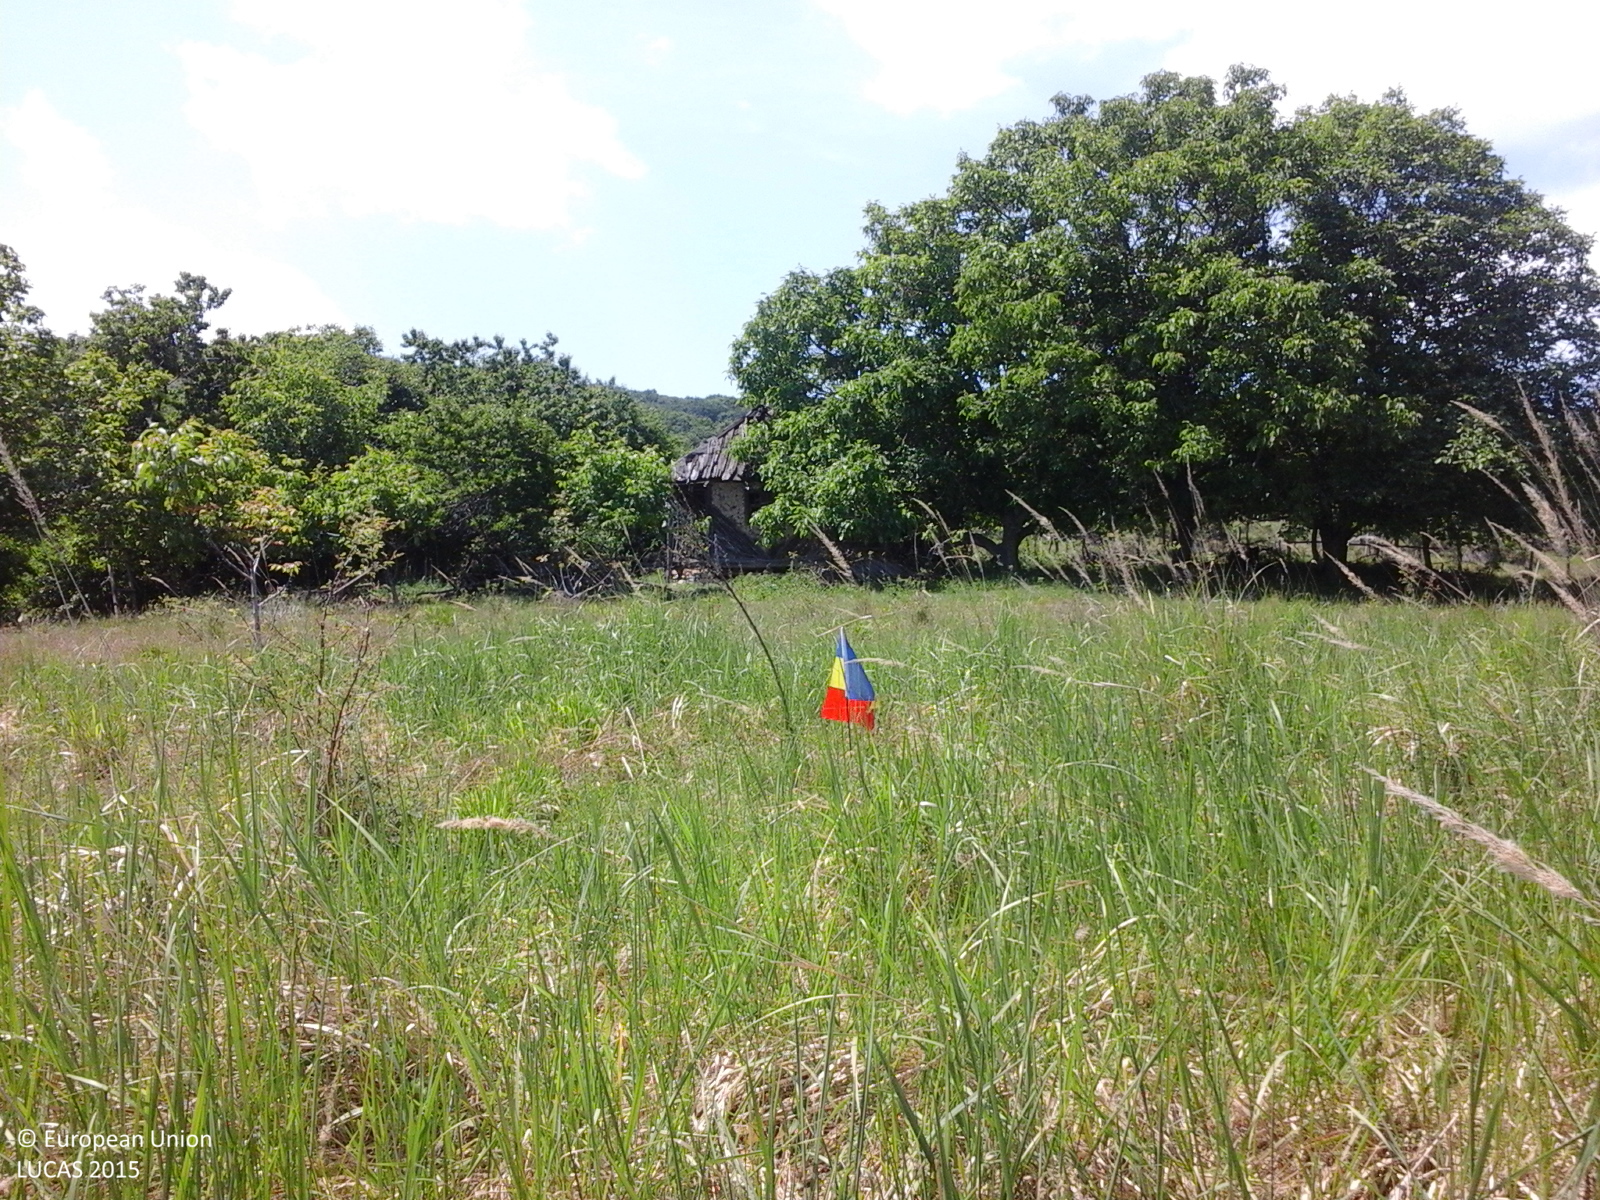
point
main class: Grassland
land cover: Grassland without tree/shrub cover
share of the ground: > 75 %
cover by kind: herbaceous plants 95 %, shrubs 5 %
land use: Agriculture (excluding fallow land and kitchen gardens)
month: June
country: RO
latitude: 46.3459
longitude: 26.8389
